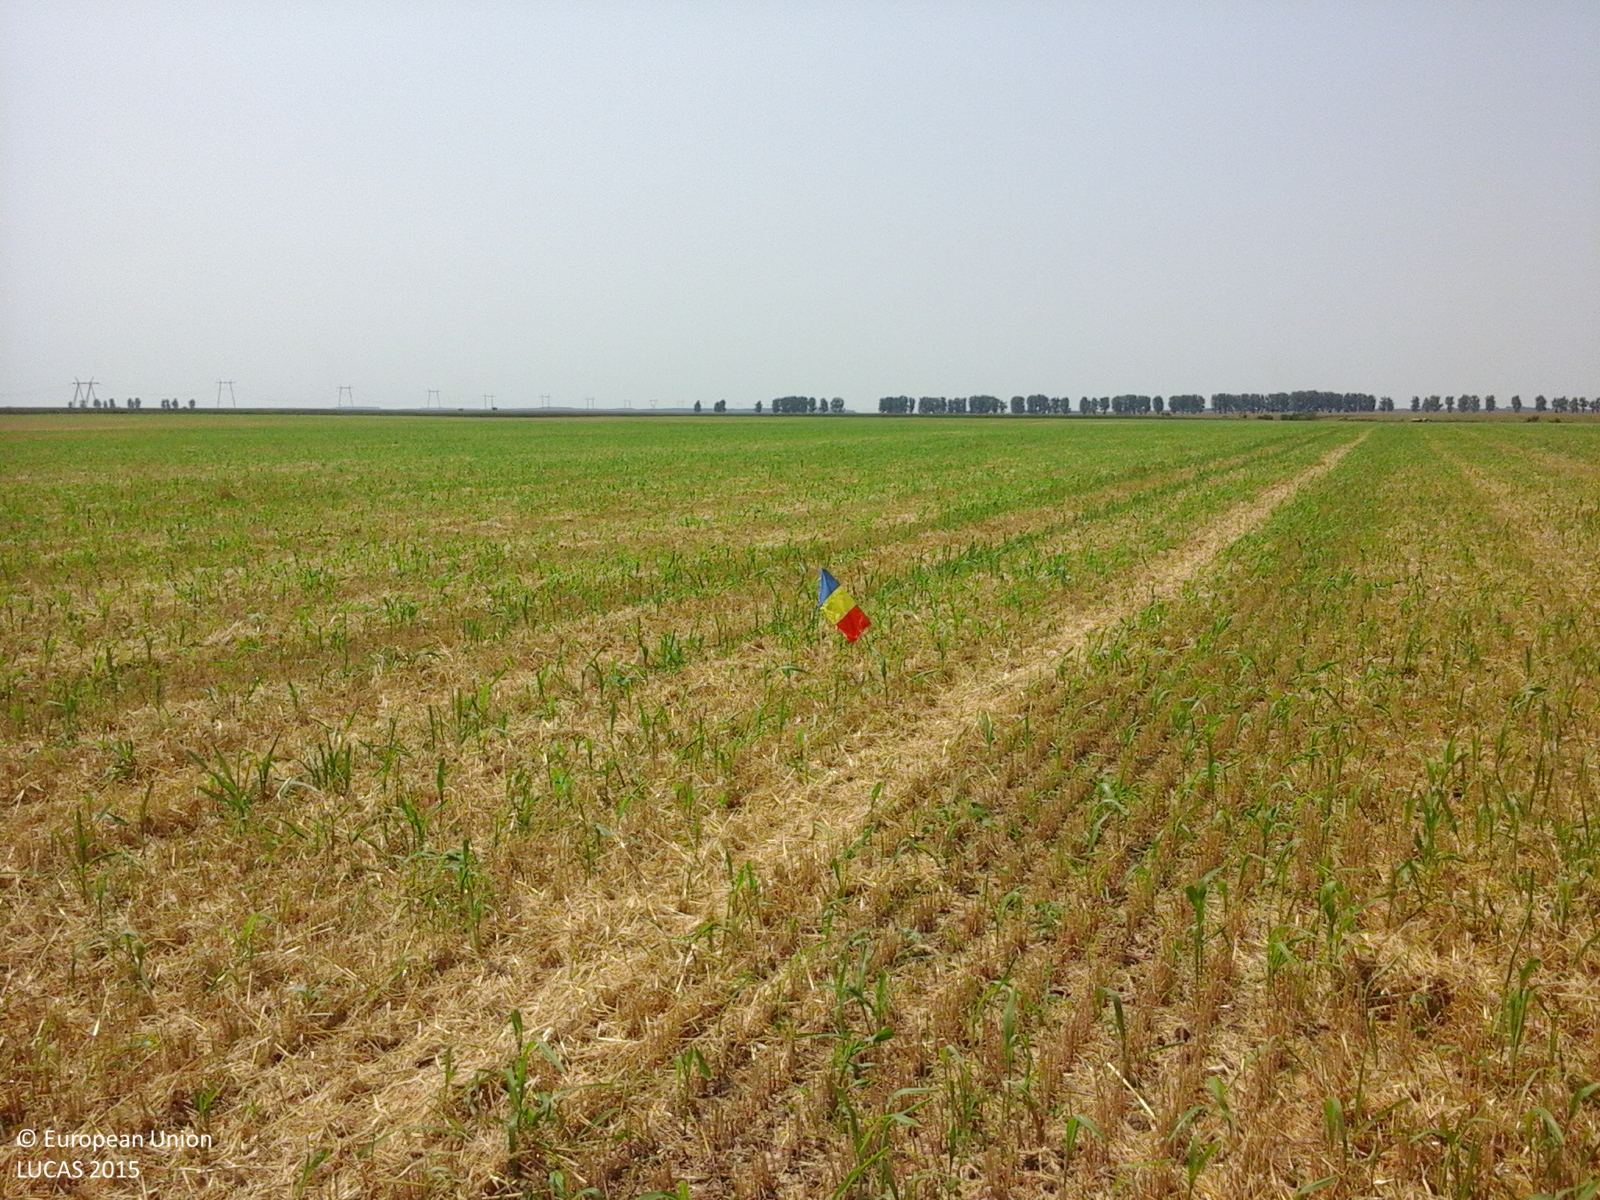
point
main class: Cropland
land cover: Common wheat
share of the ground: > 75 %
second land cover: Spontaneously vegetated surfaces
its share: 10 - 25 %
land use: Agriculture (excluding fallow land and kitchen gardens)
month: July
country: RO
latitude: 44.5621
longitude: 26.7289
